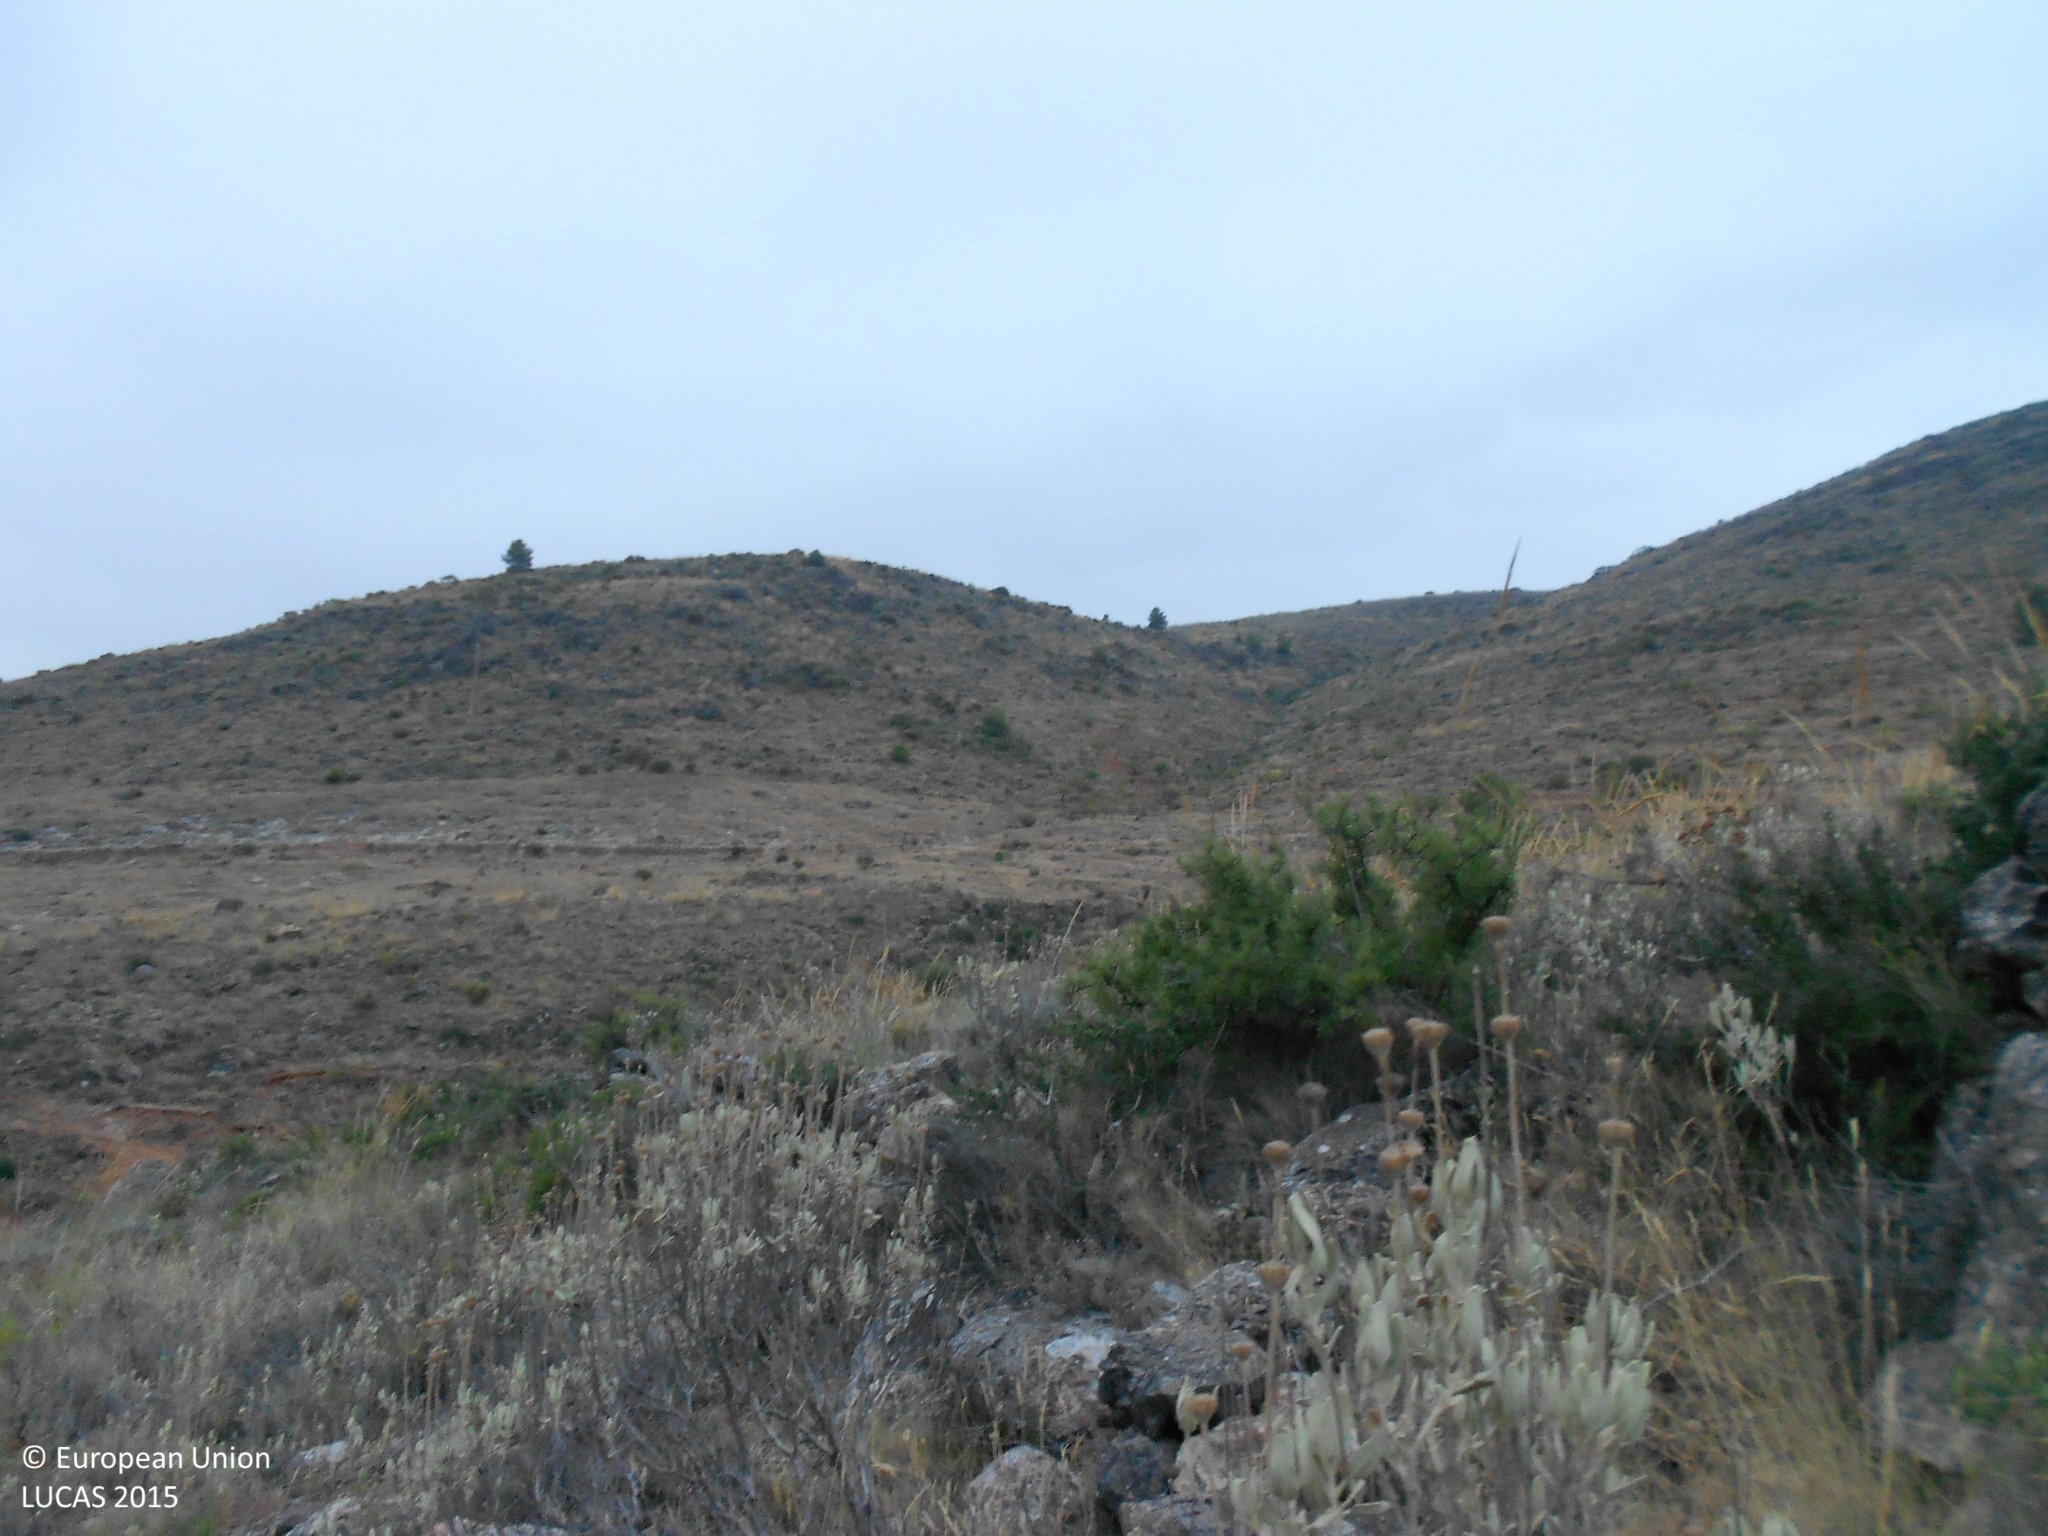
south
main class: Shrubland
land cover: Shrubland without tree cover
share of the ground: 50 - 75 %
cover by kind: shrubs 60 %, herbaceous plants 20 %, consolidated bare surface 20 %
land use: Semi-natural and natural areas not in use
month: July
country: ES
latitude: 36.9858
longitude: -2.8213
